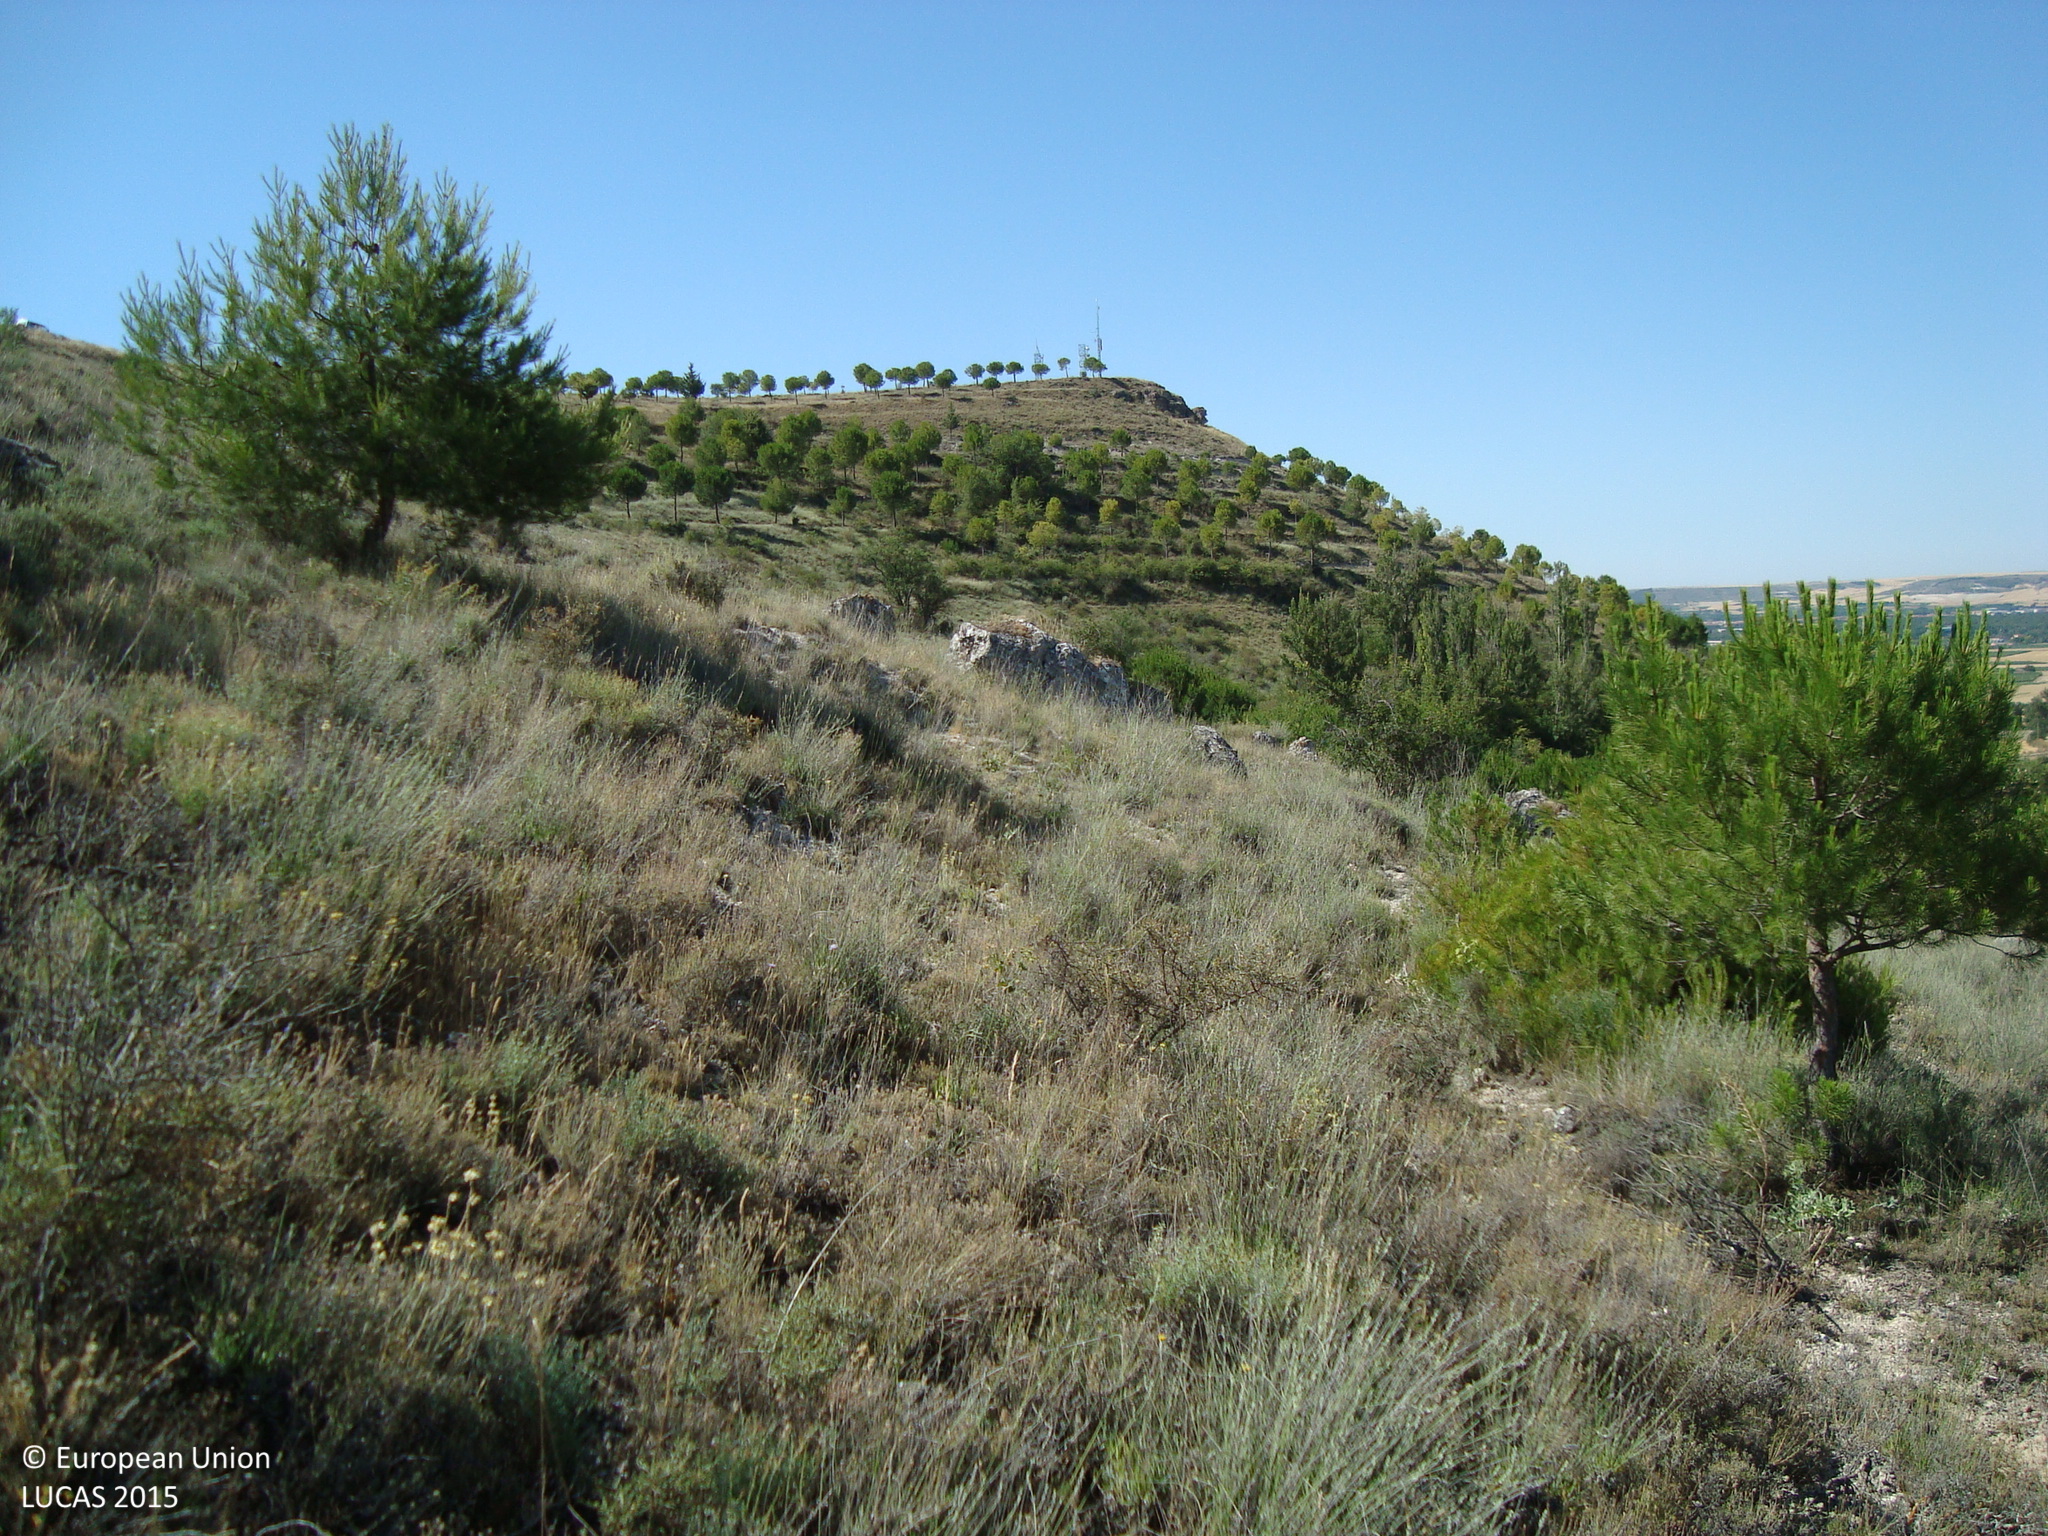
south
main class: Shrubland
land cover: Shrubland with sparse tree cover
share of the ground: 50 - 75 %
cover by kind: shrubs 60 %, herbaceous plants 20 %, unconsolidated bare surface 15 %, coniferous forest trees 5 %
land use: Forestry
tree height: < 5 m
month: July
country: ES
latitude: 41.6446
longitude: -4.0939
